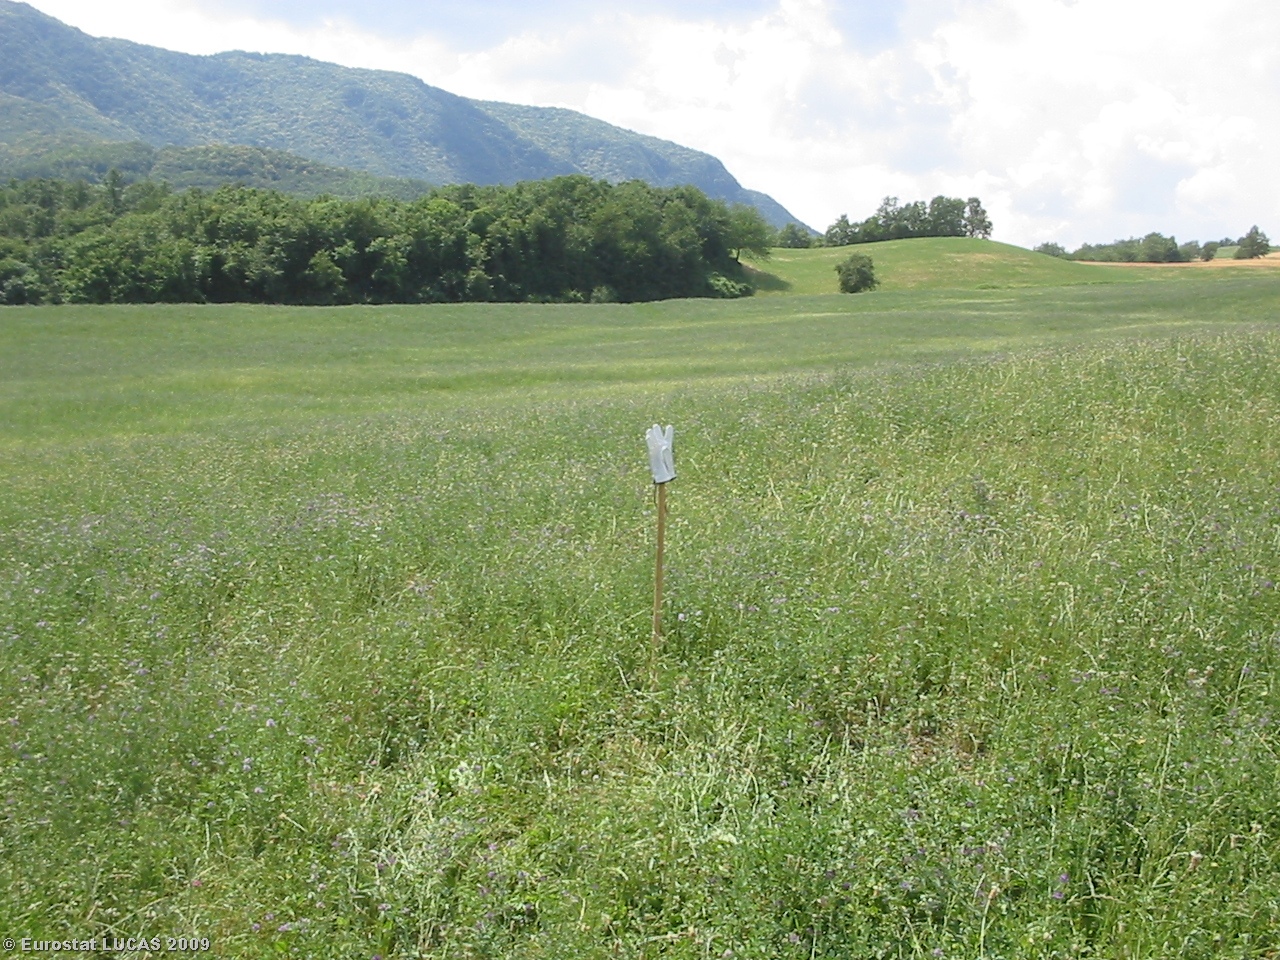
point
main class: Cropland
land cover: Lucerne
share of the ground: > 75 %
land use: Agriculture (excluding fallow land and kitchen gardens)
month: July
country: IT
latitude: 44.5306
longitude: 10.2637
